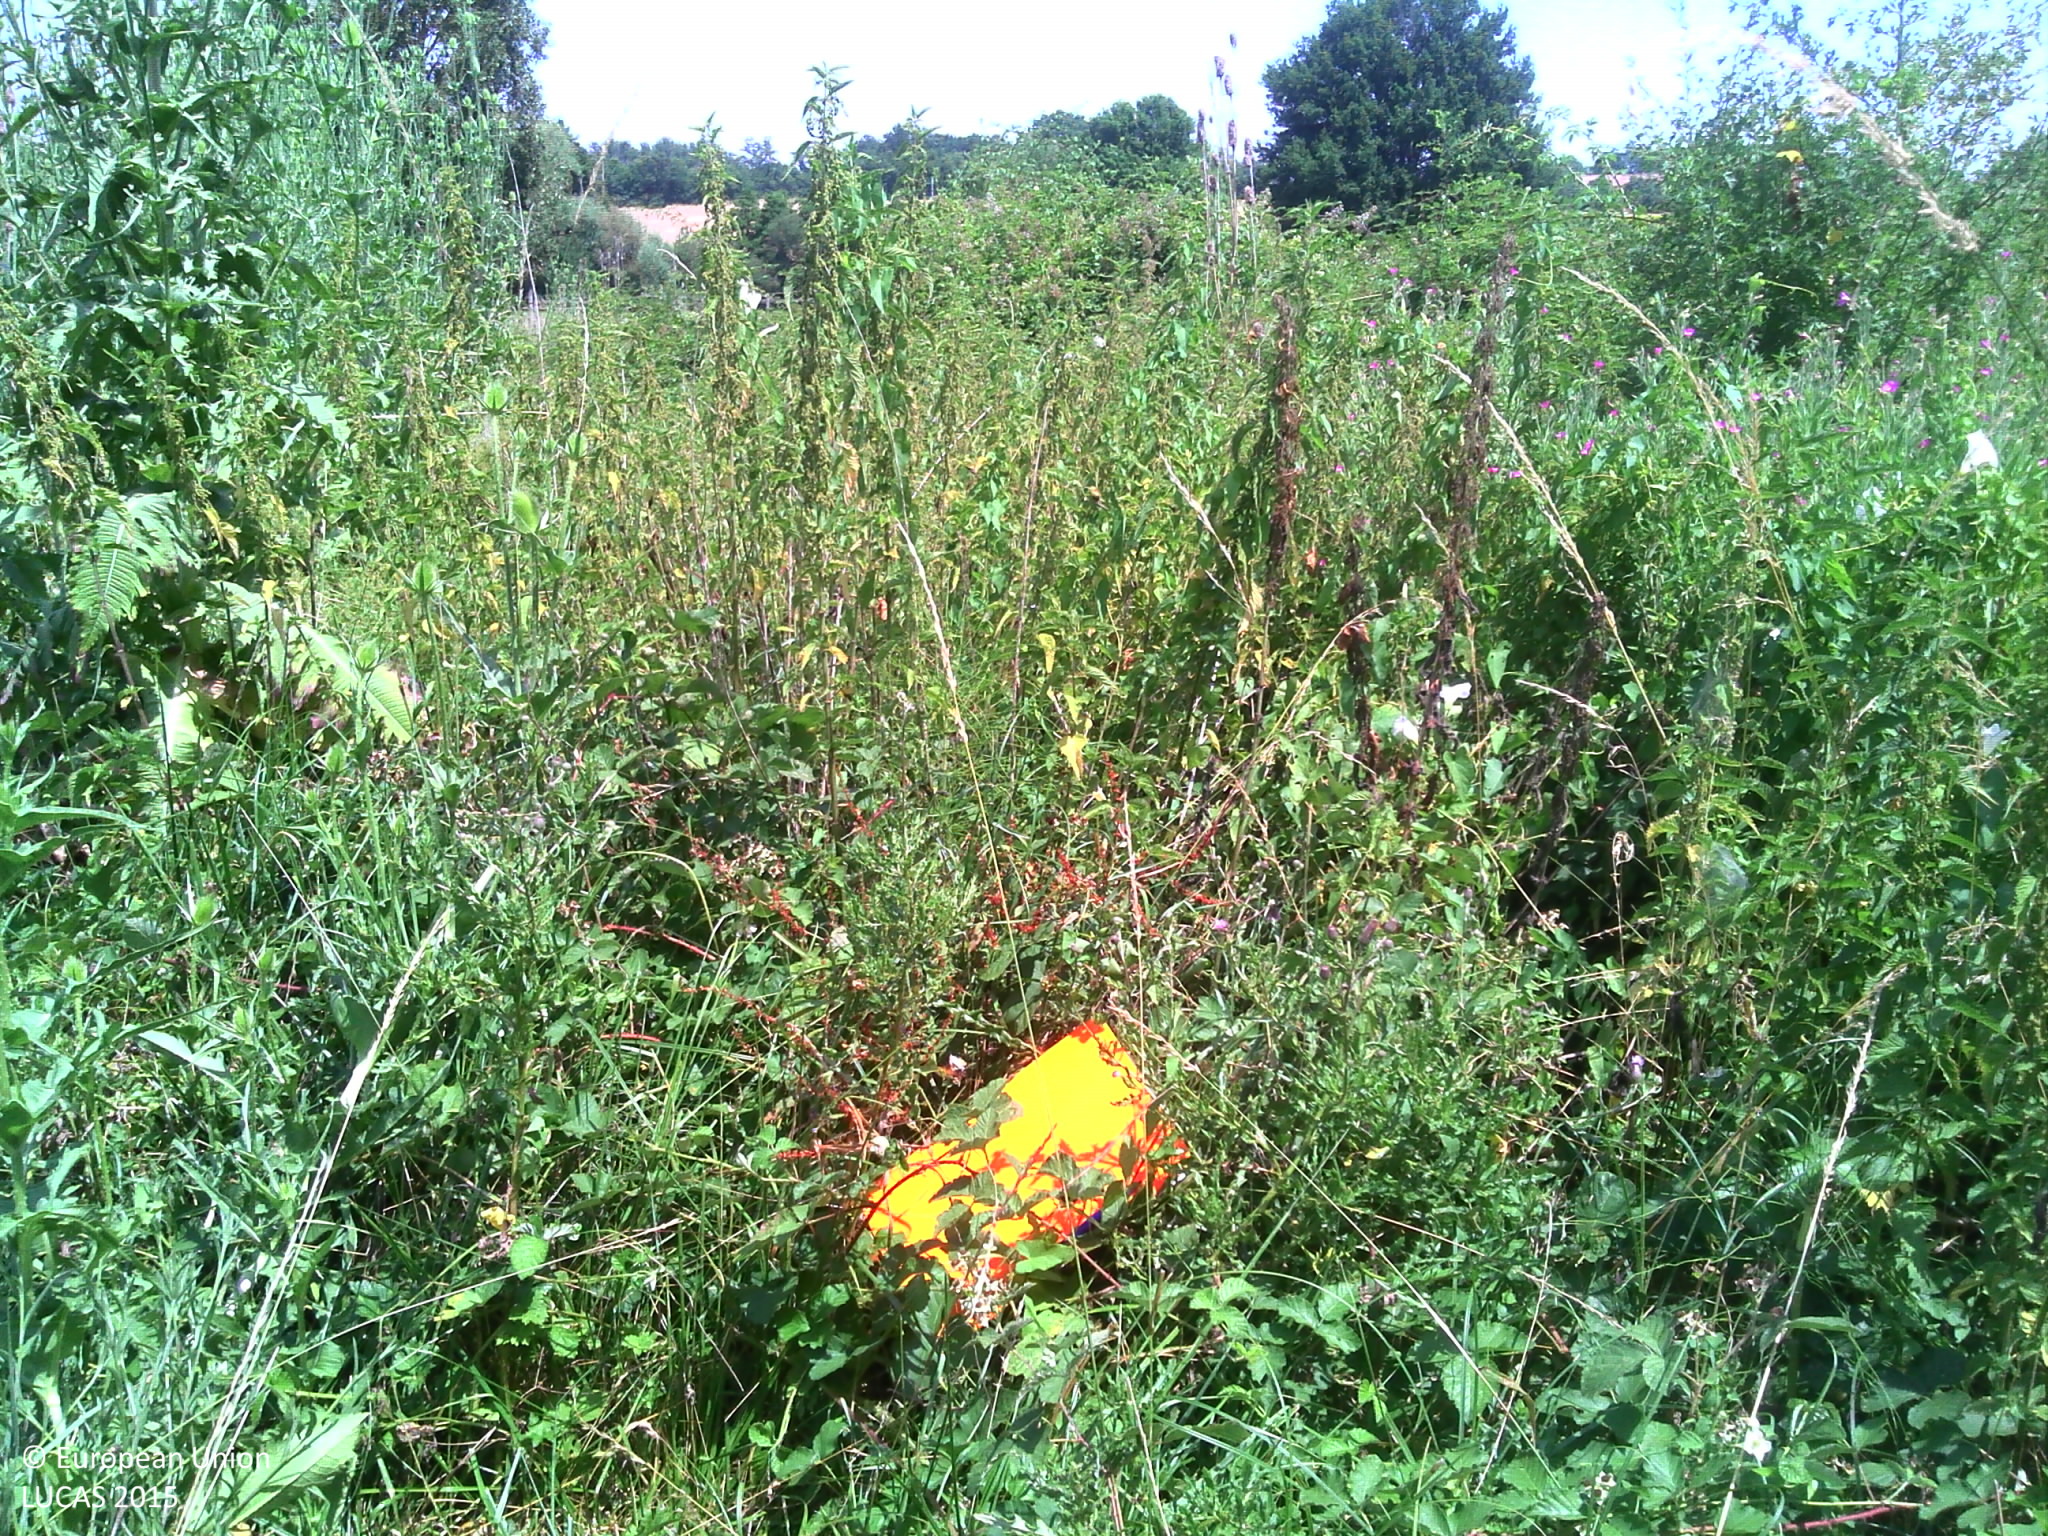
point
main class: Grassland
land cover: Grassland without tree/shrub cover
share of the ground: > 75 %
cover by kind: herbaceous plants 95 %, shrubs 5 %
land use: Agriculture (excluding fallow land and kitchen gardens)
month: July
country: FR
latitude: 43.7214
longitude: 1.6240
